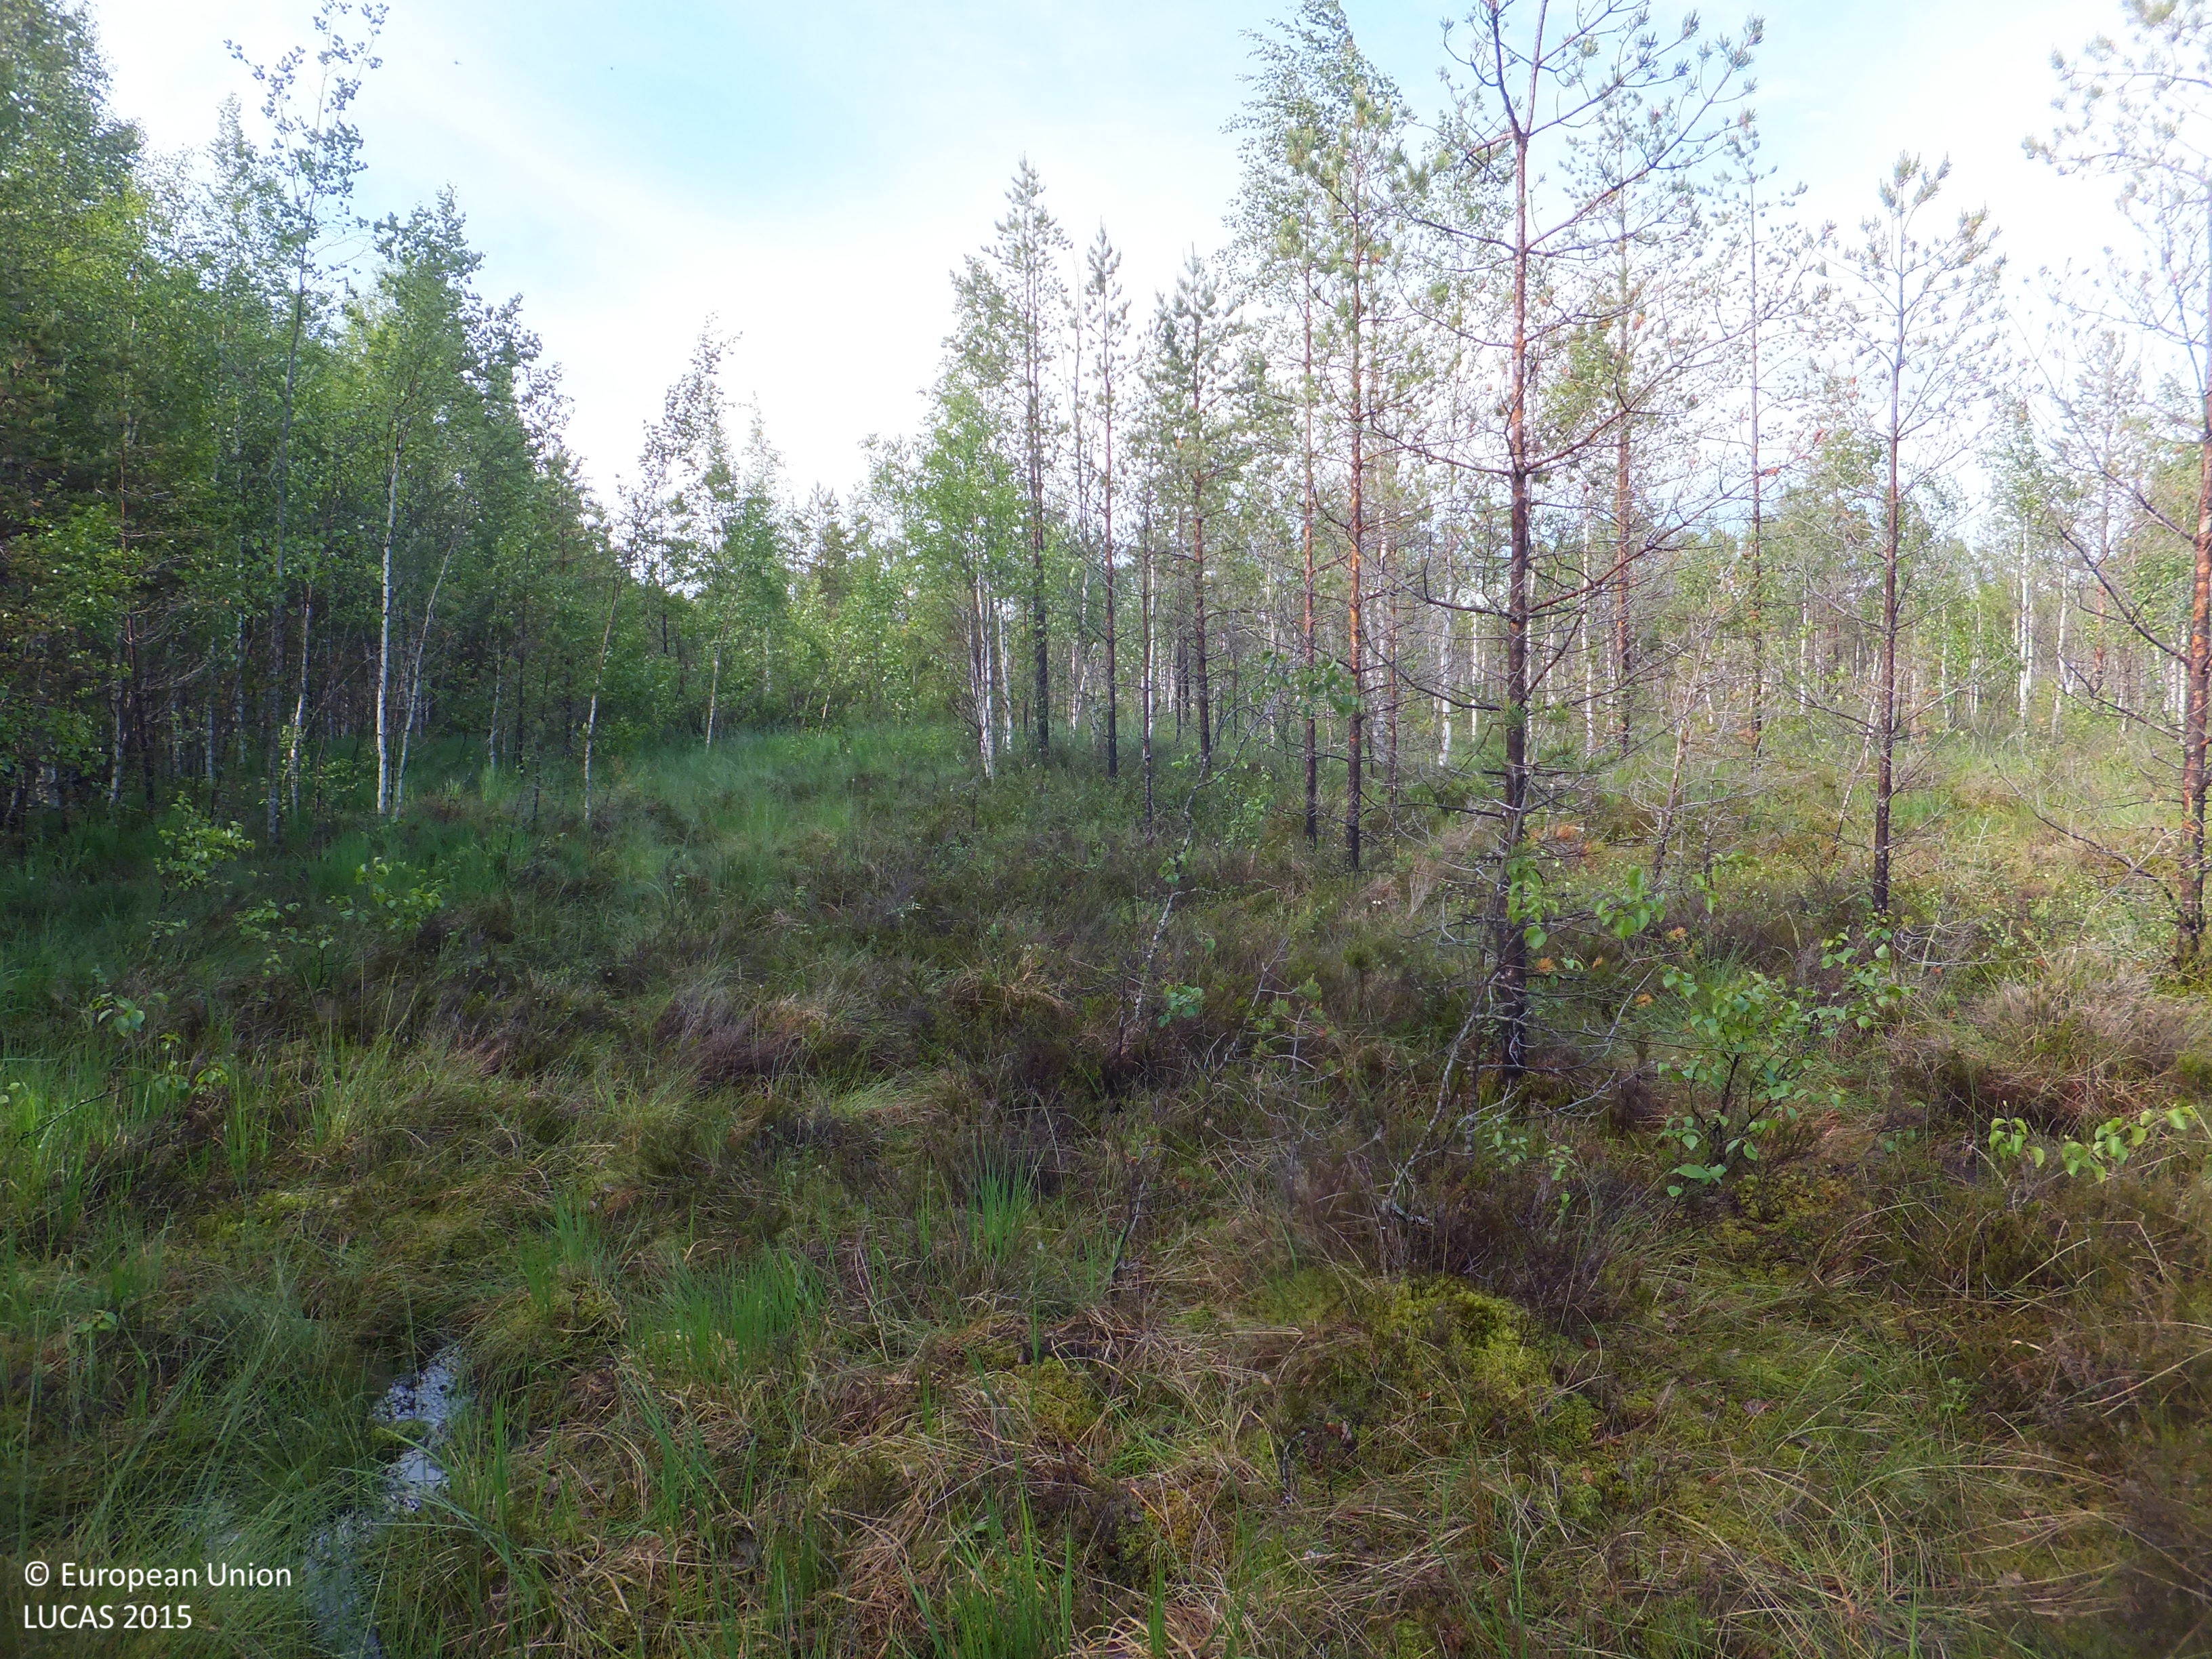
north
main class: Woodland
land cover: Broadleaved woodland
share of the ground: 25 - 50 %
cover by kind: broadleaved forest trees 30 %, herbaceous plants 30 %, shrubs 20 %, lichens and mosses 10 %
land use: Semi-natural and natural areas not in use
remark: Temporary flooded
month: June
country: FI
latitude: 63.4325
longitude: 24.6941
